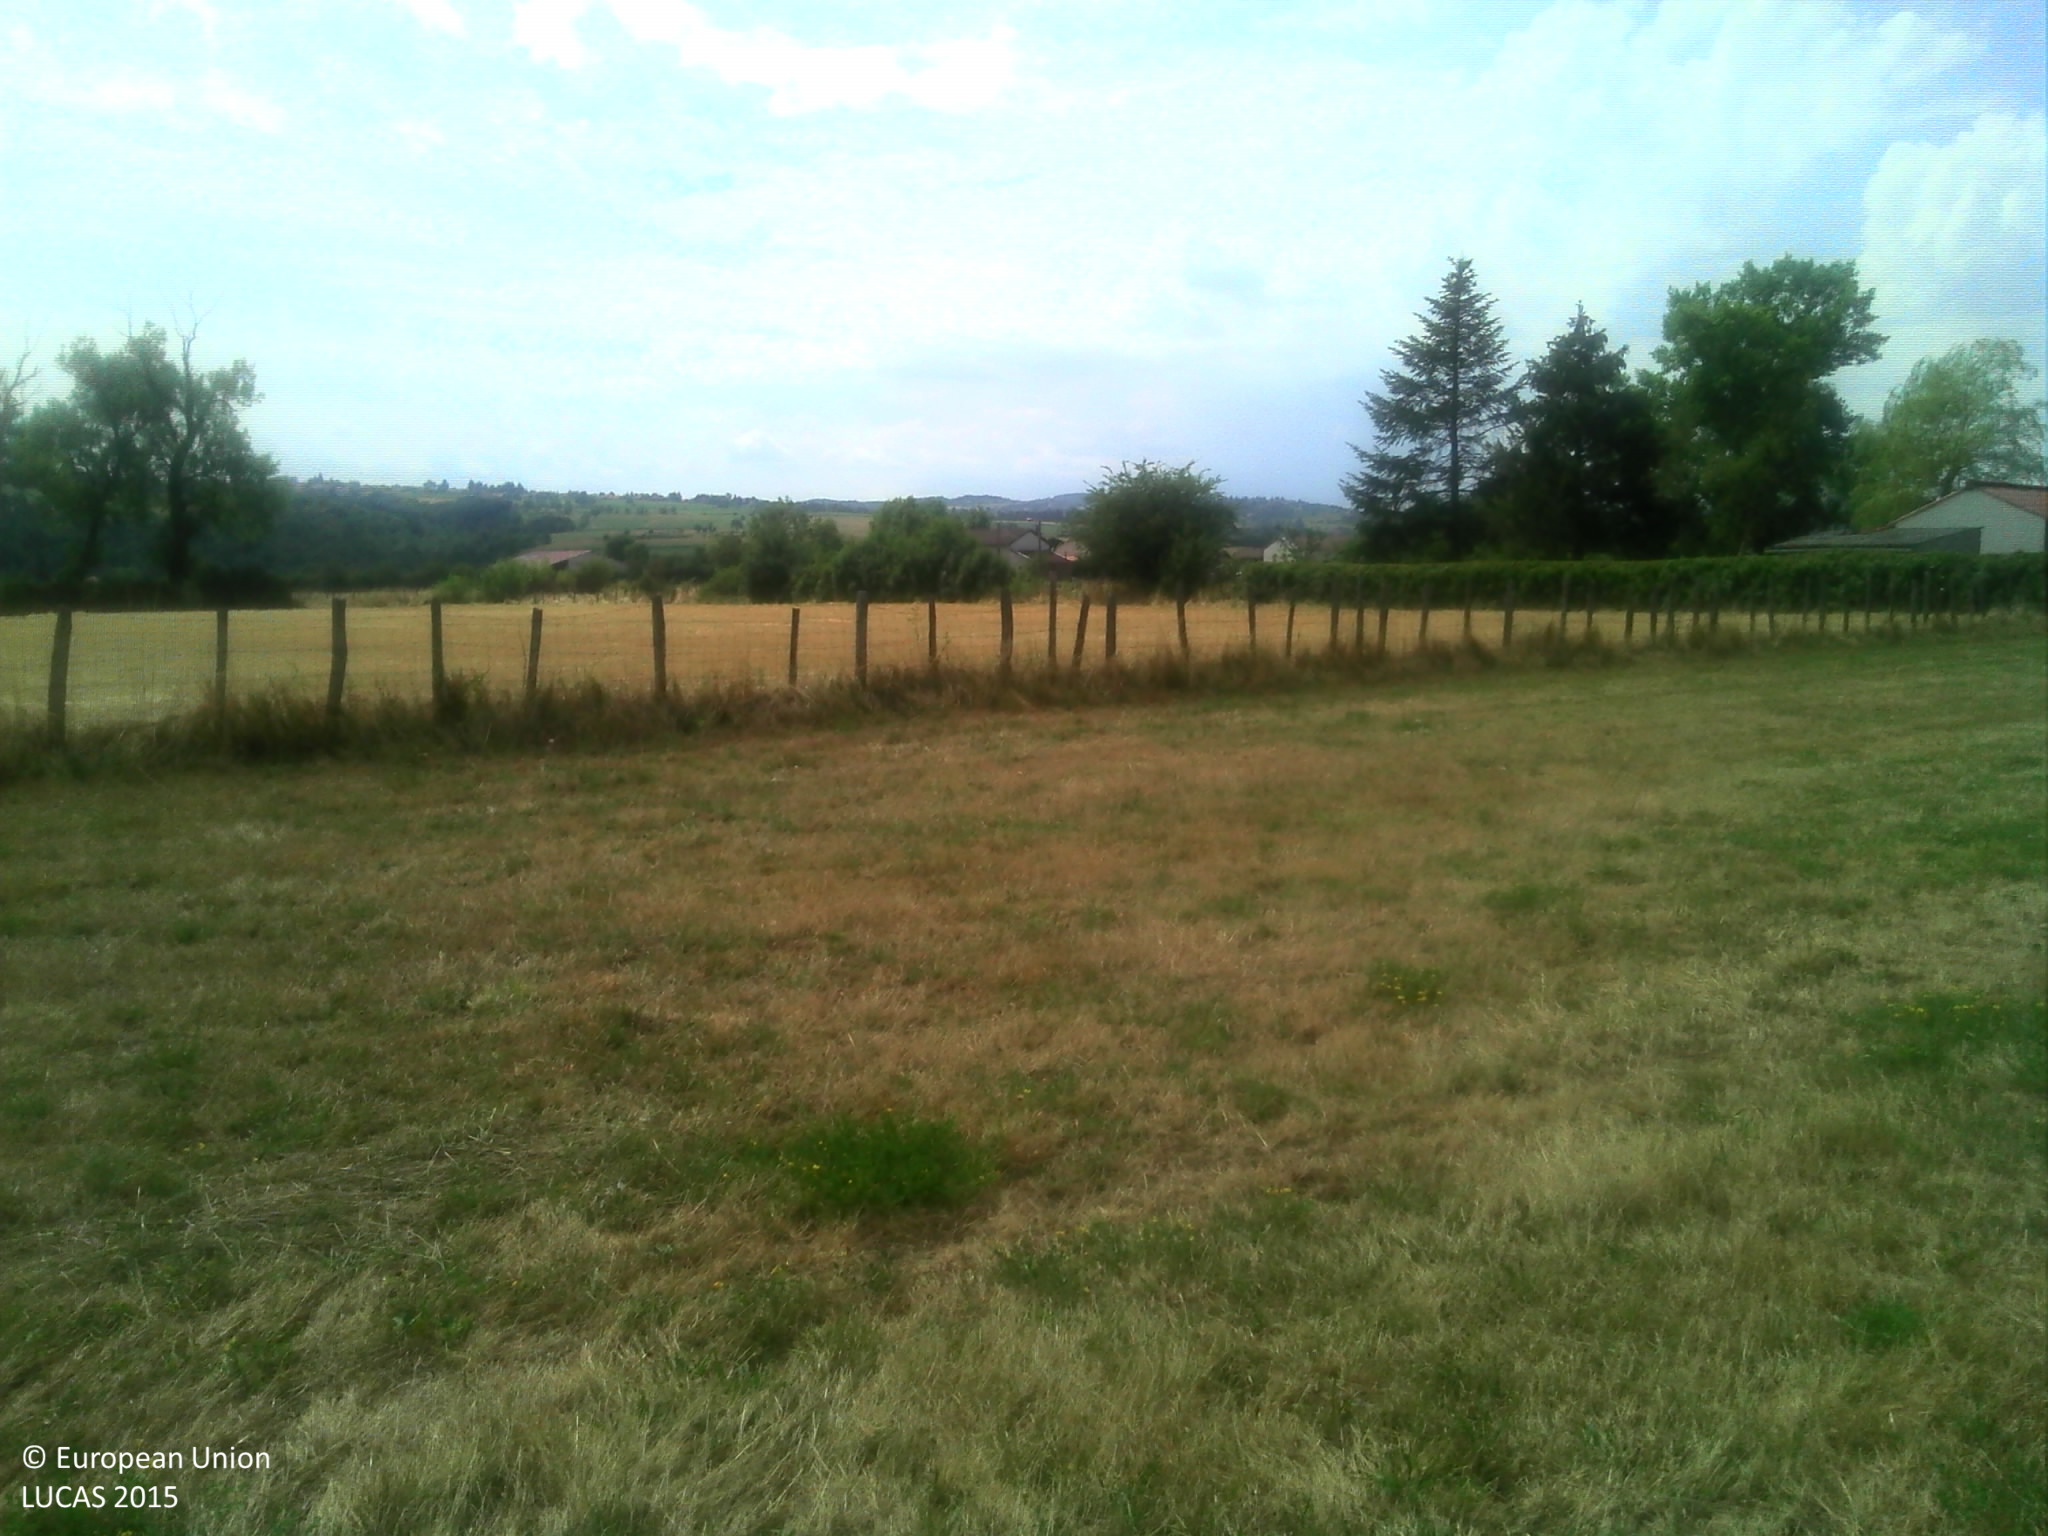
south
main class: Grassland
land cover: Grassland without tree/shrub cover
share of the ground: > 75 %
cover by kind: herbaceous plants 100 %
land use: Agriculture (excluding fallow land and kitchen gardens)
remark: Harvested field
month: July
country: FR
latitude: 45.3240
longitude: 4.1478
